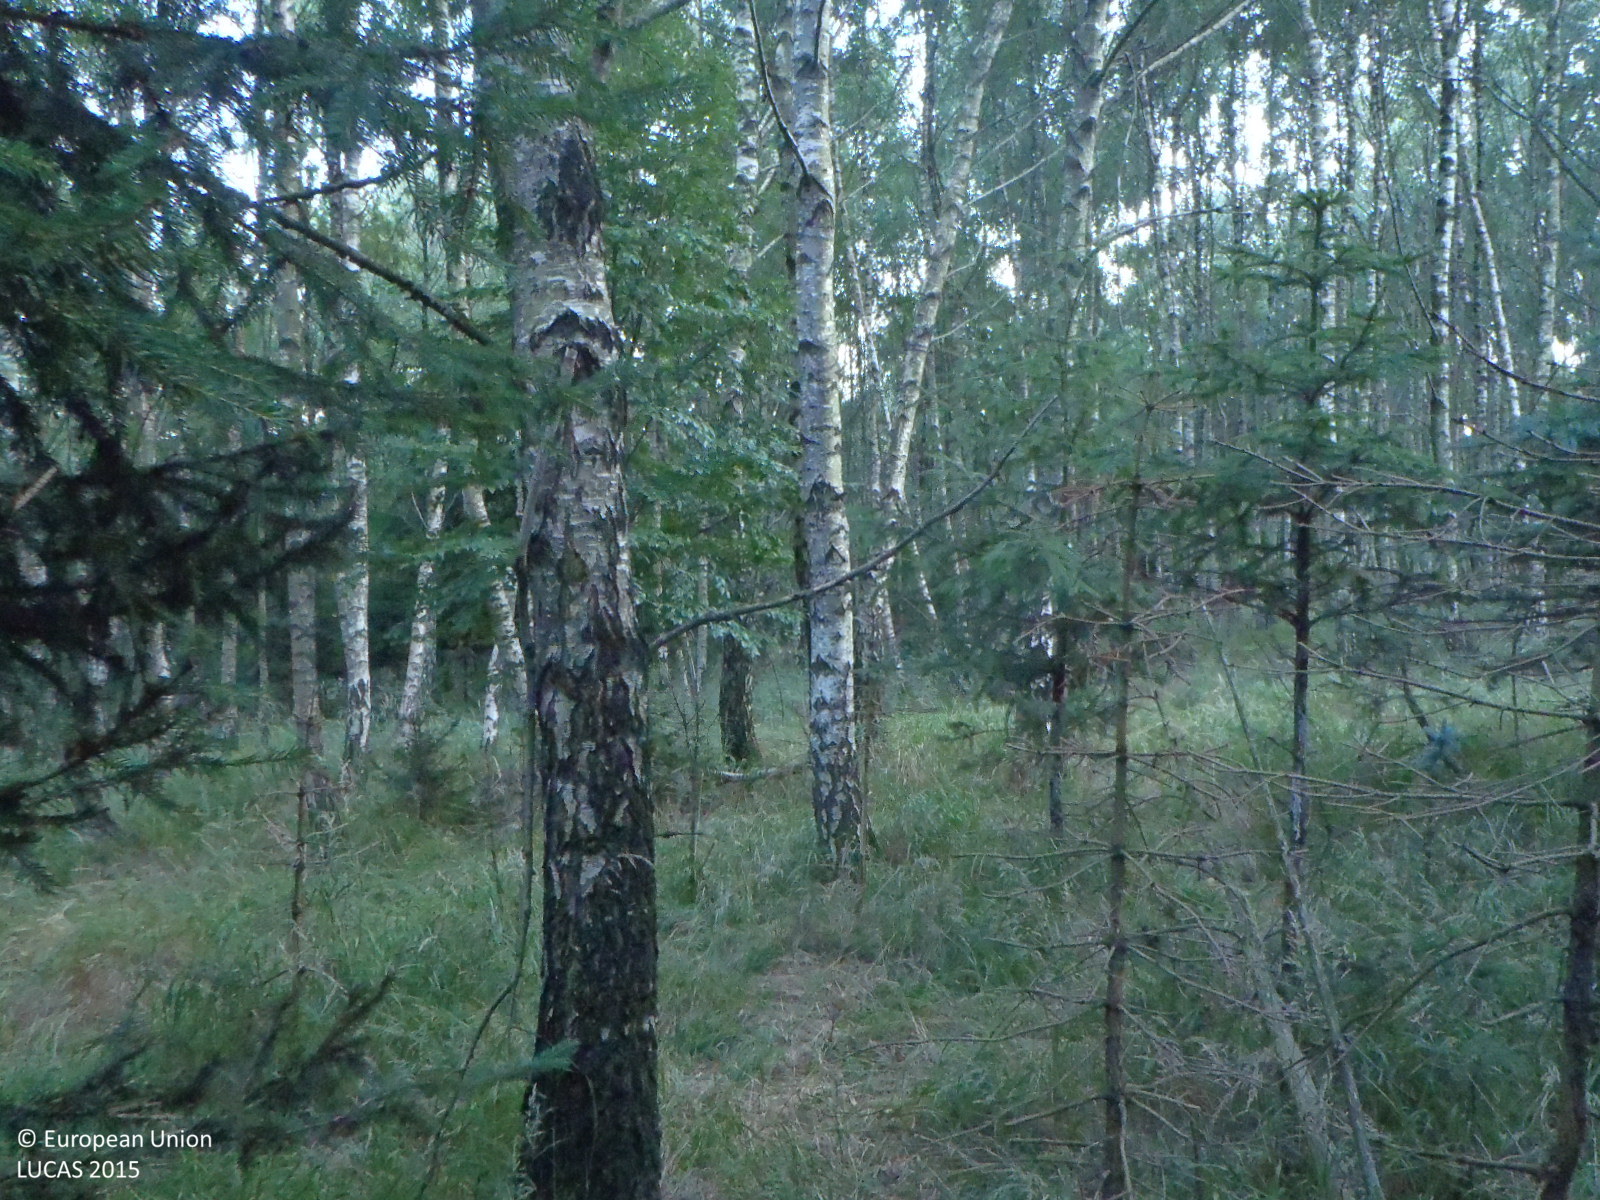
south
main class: Woodland
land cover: Spruce dominated mixed woodland
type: hemiboreal forest and nemoral coniferous forest and mixed broadleaved-coniferous forest
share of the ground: > 75 %
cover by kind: coniferous forest trees 50 %, broadleaved forest trees 50 %
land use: Forestry
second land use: Community services
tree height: > 5 m
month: September
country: CZ
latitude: 50.7618
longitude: 14.0131
